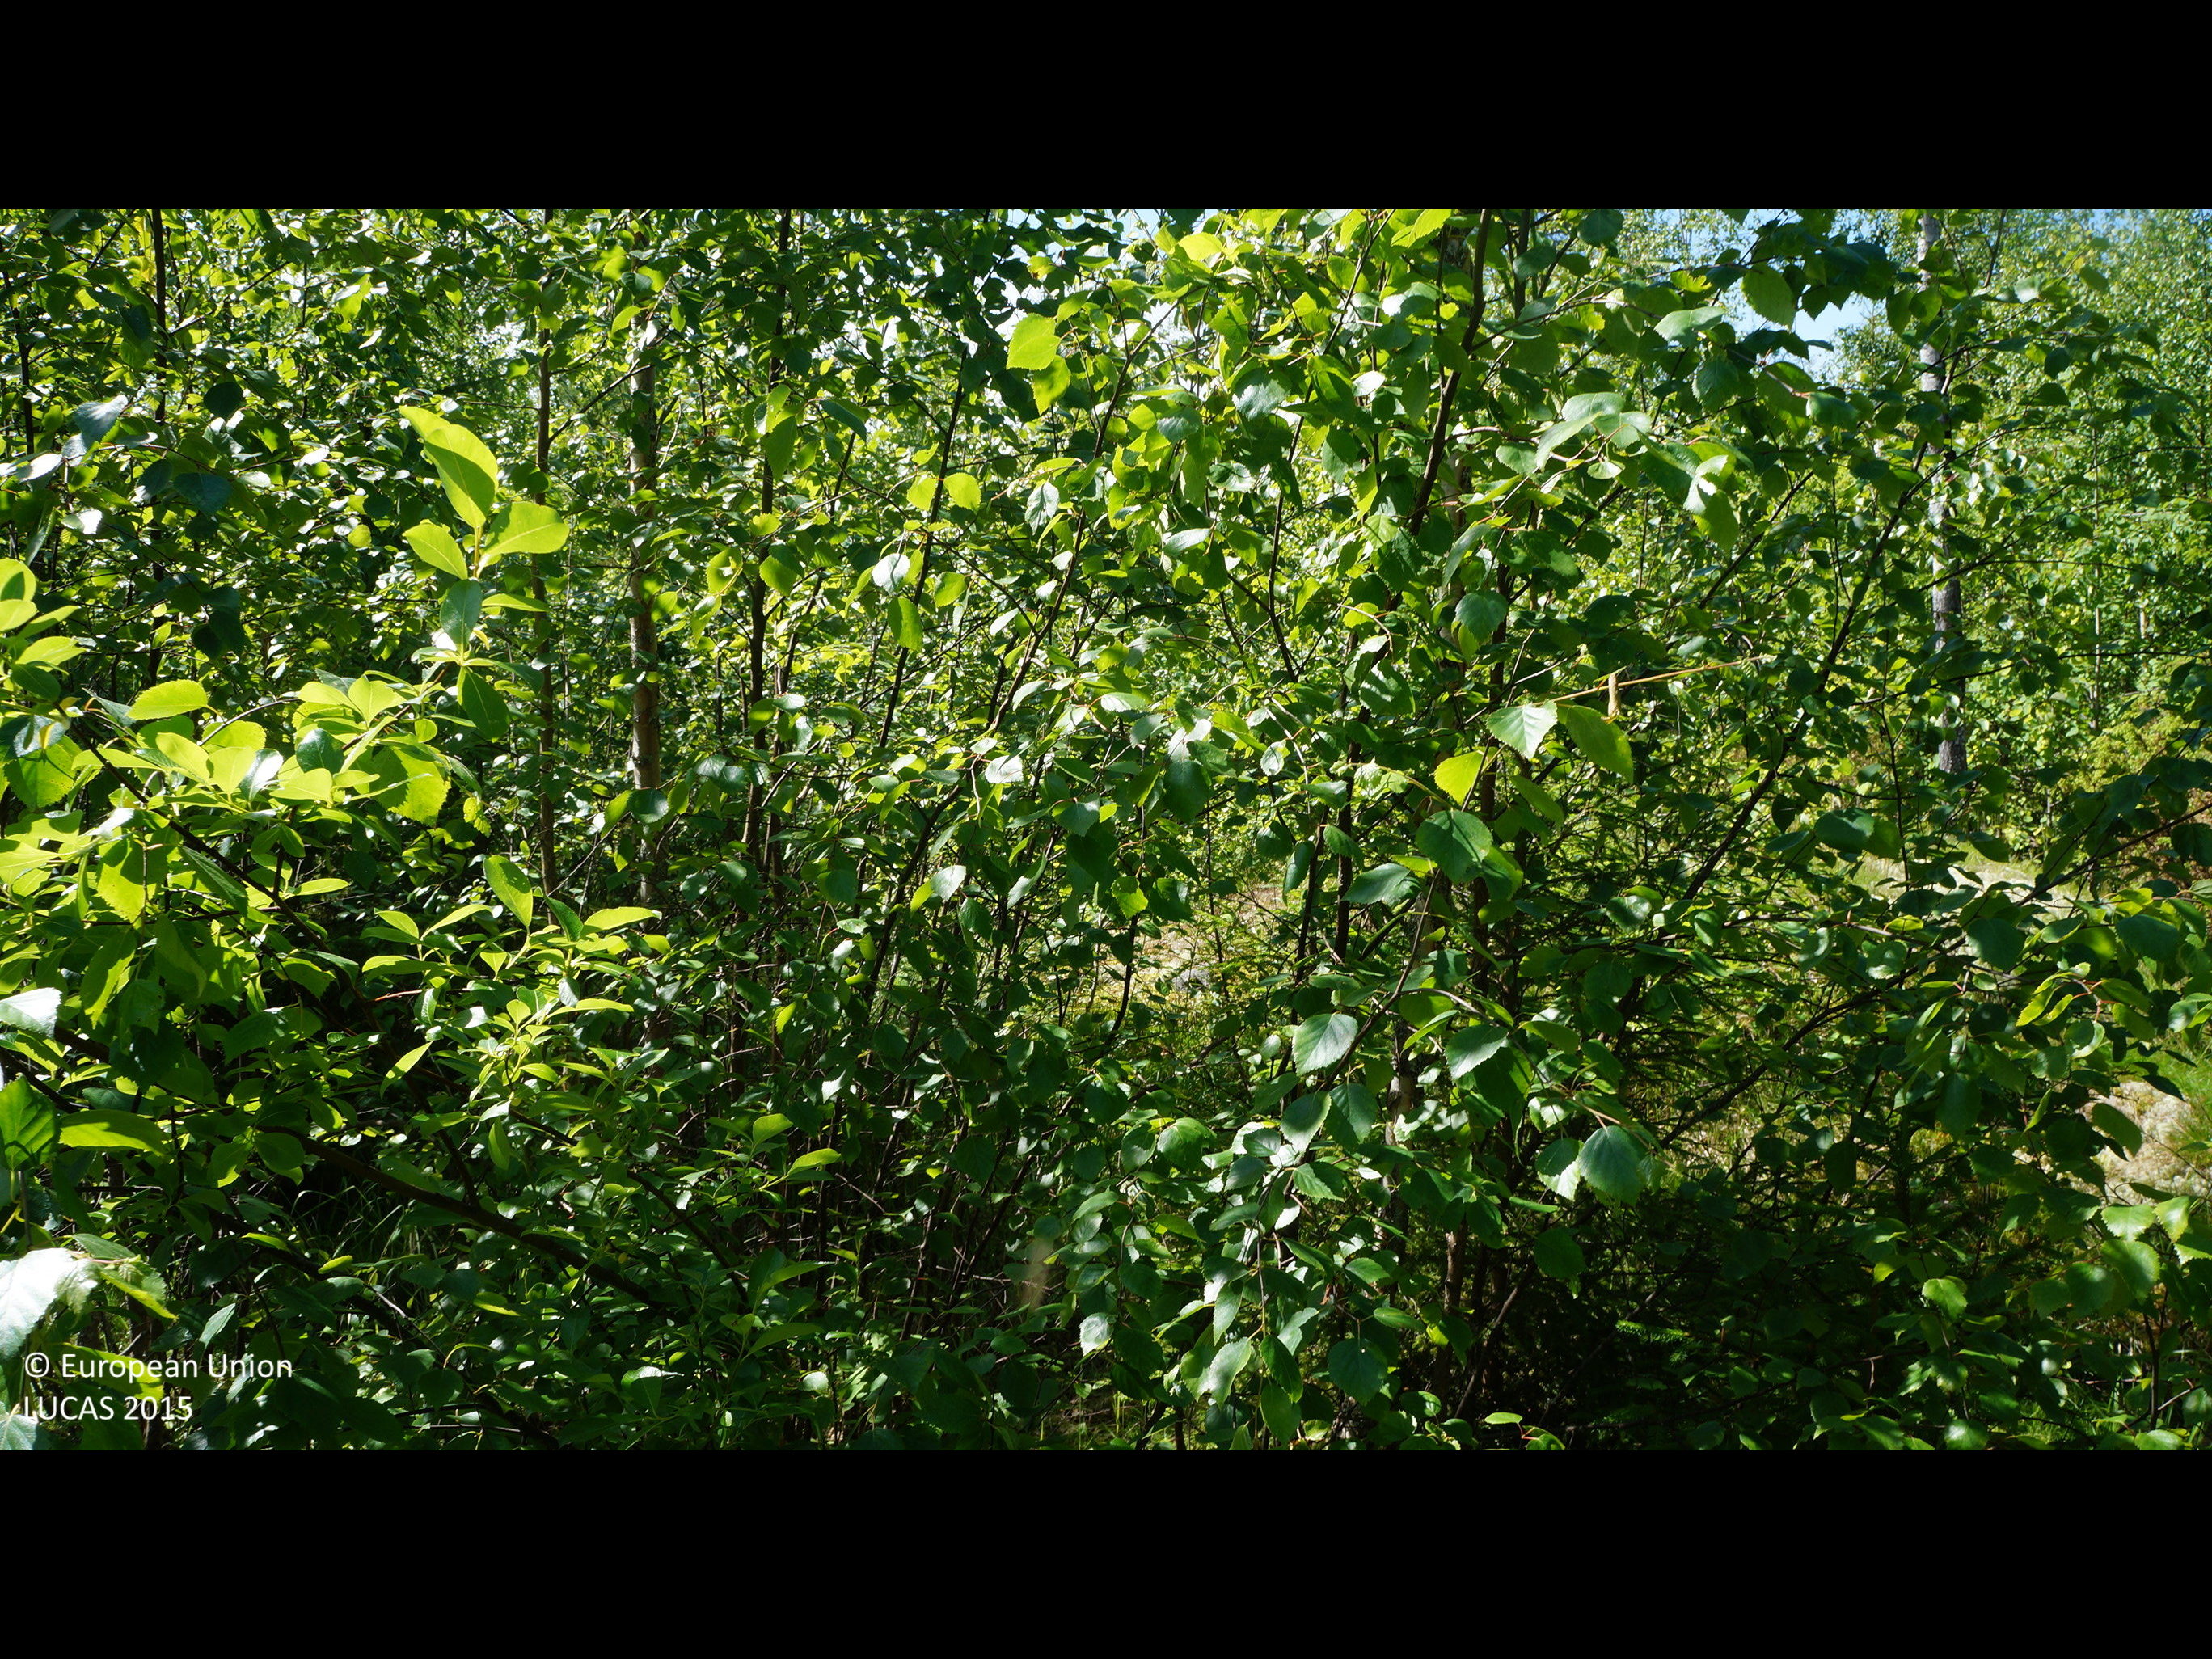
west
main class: Woodland
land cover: Broadleaved woodland
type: boreal forest
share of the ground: 50 - 75 %
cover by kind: broadleaved forest trees 40 %, shrubs 30 %, herbaceous plants 20 %, coniferous forest trees 10 %
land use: Forestry
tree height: > 5 m
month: July
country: FI
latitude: 64.1740
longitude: 24.4530
